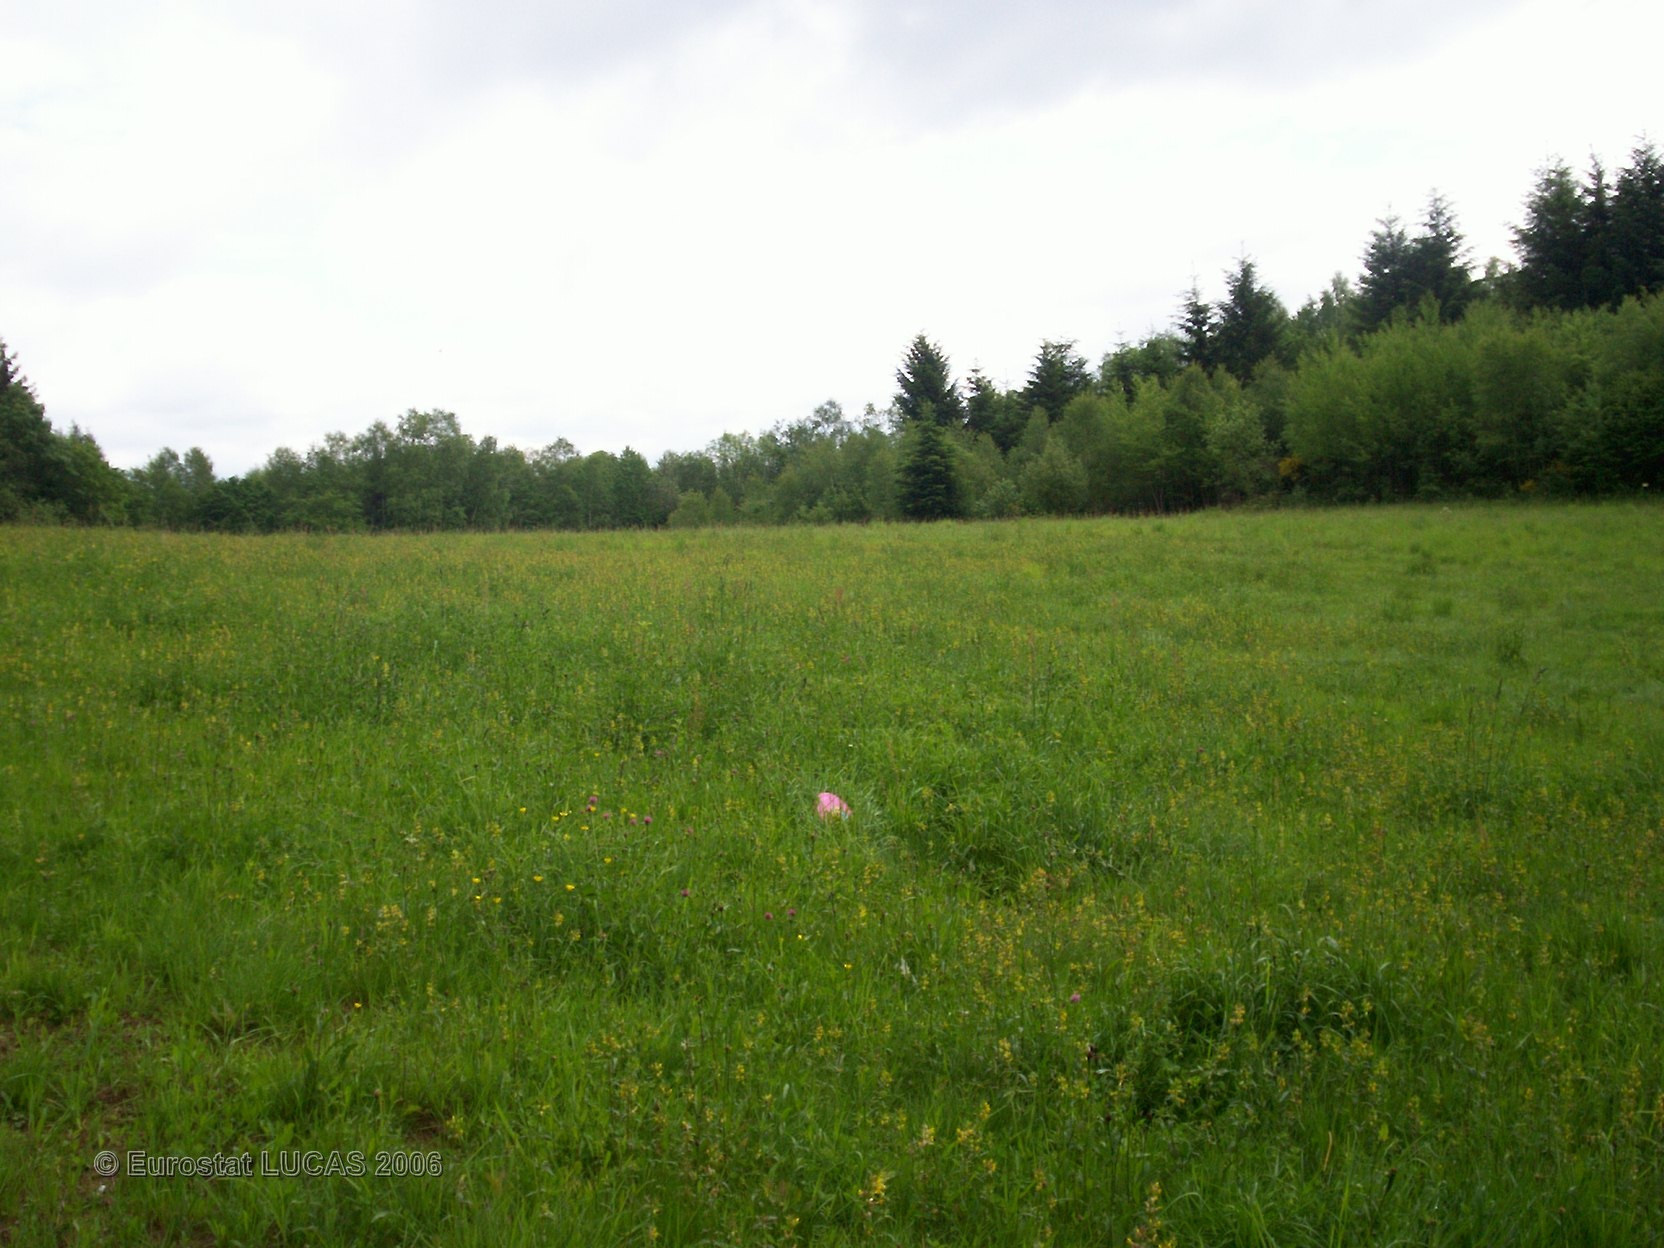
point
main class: Grassland
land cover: Grassland without tree/shrub cover
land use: Agriculture (excluding fallow land and kitchen gardens)
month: June
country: FR
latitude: 48.3978
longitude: 6.9618
